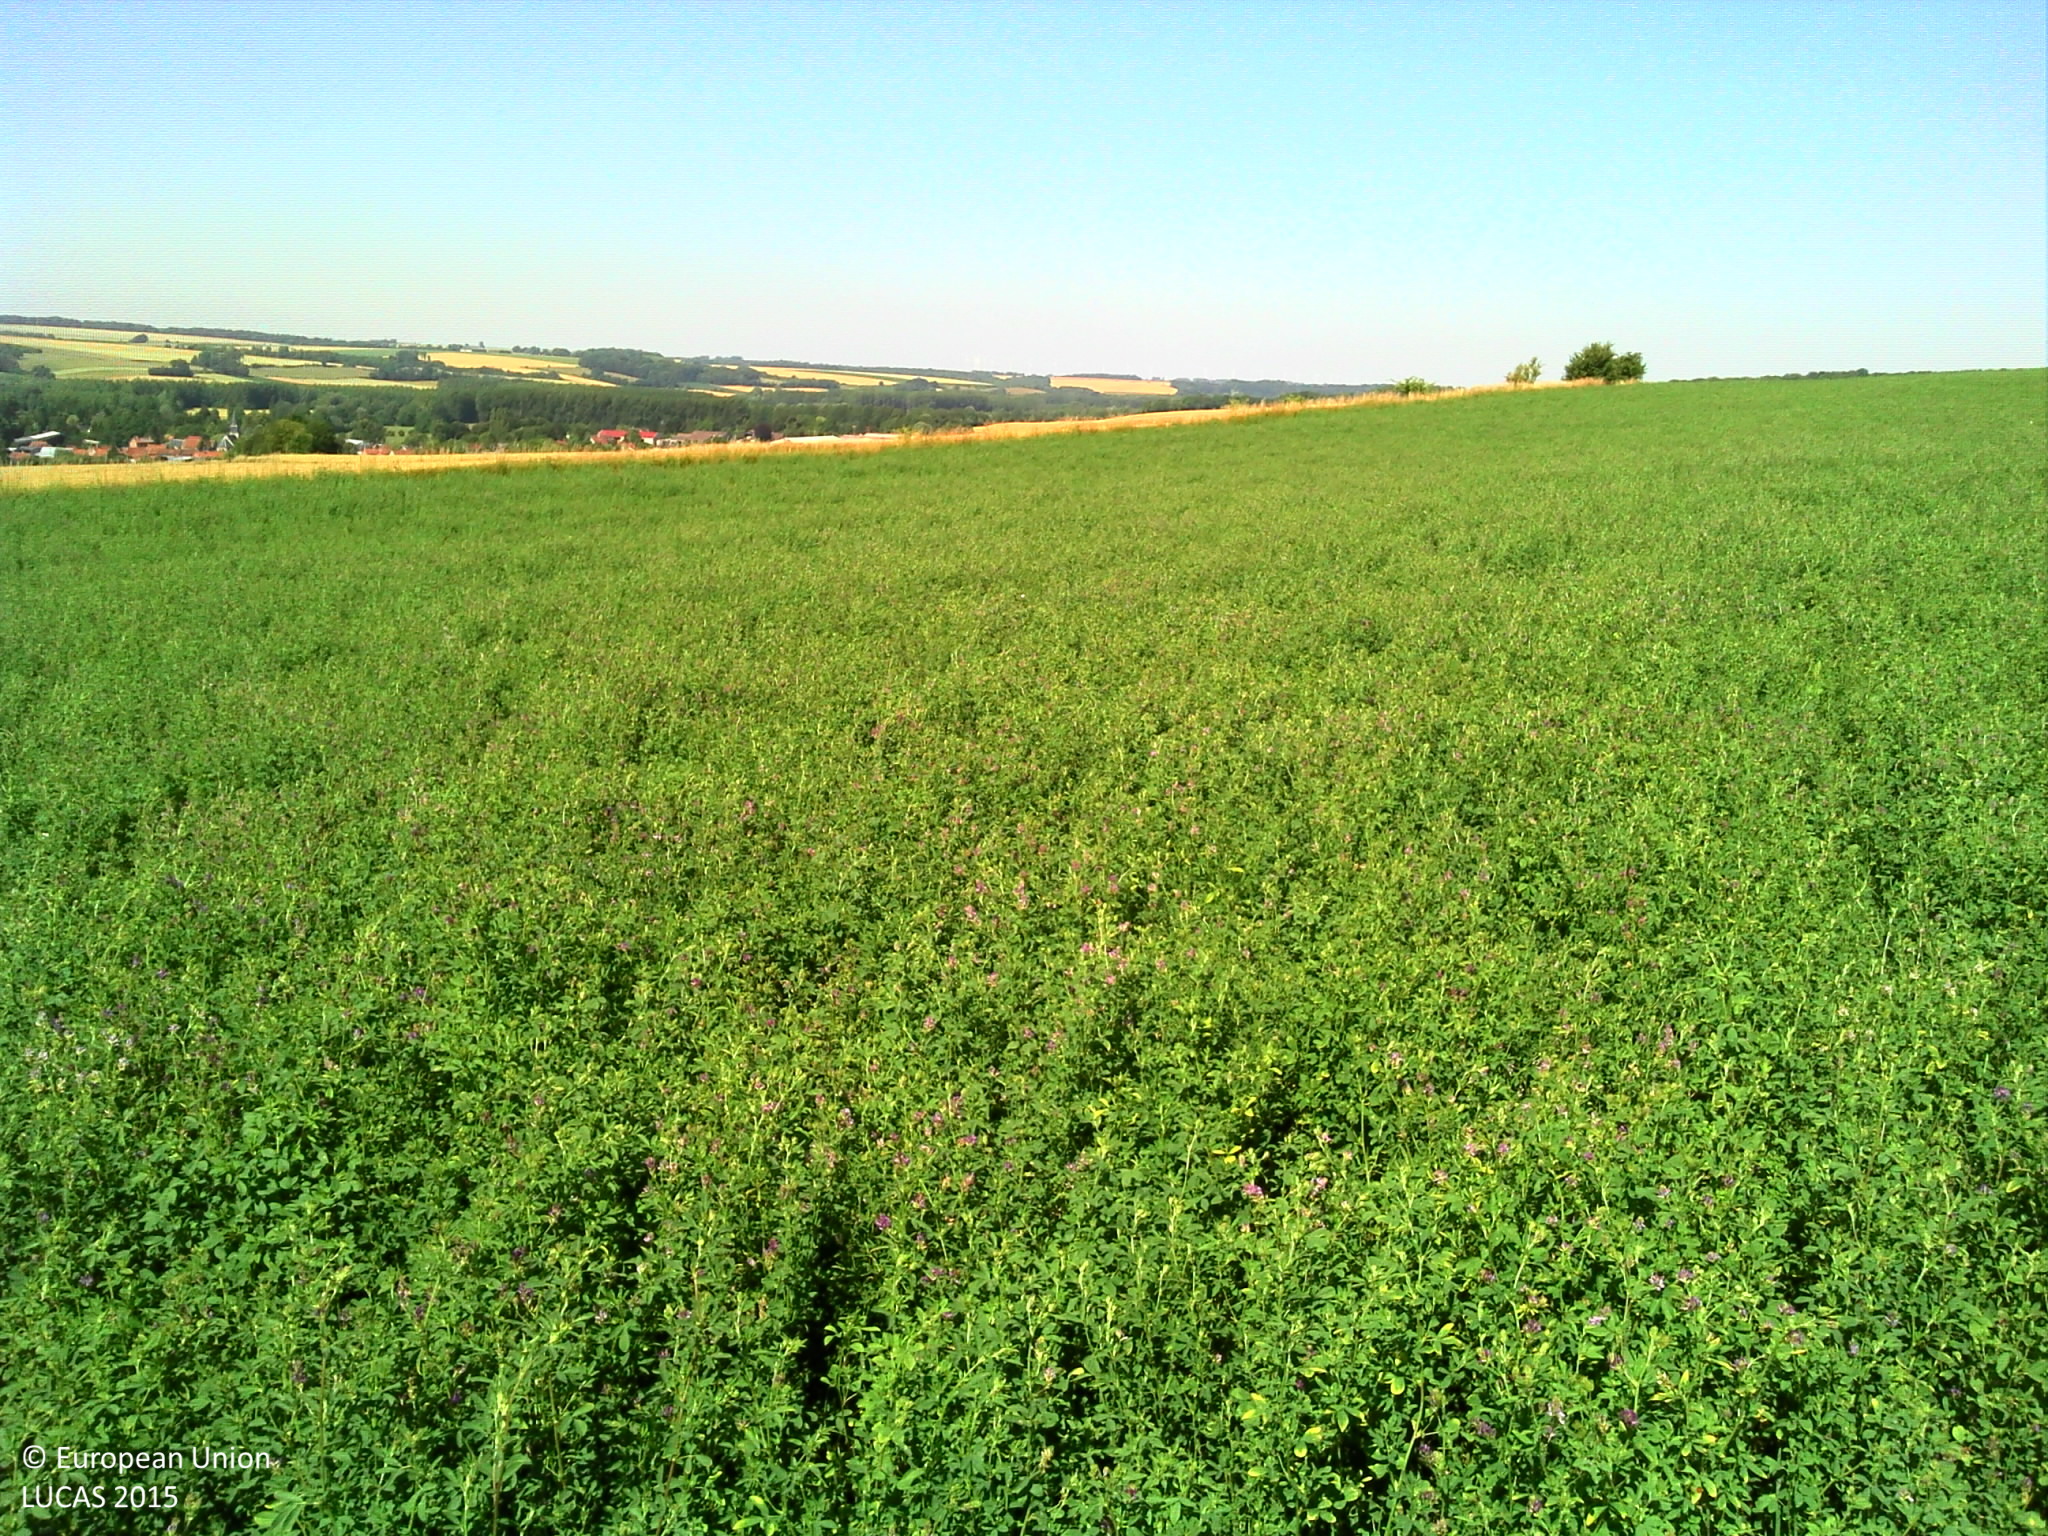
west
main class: Cropland
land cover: Lucerne
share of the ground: > 75 %
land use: Agriculture (excluding fallow land and kitchen gardens)
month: July
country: FR
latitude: 50.2225
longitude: 2.1786
